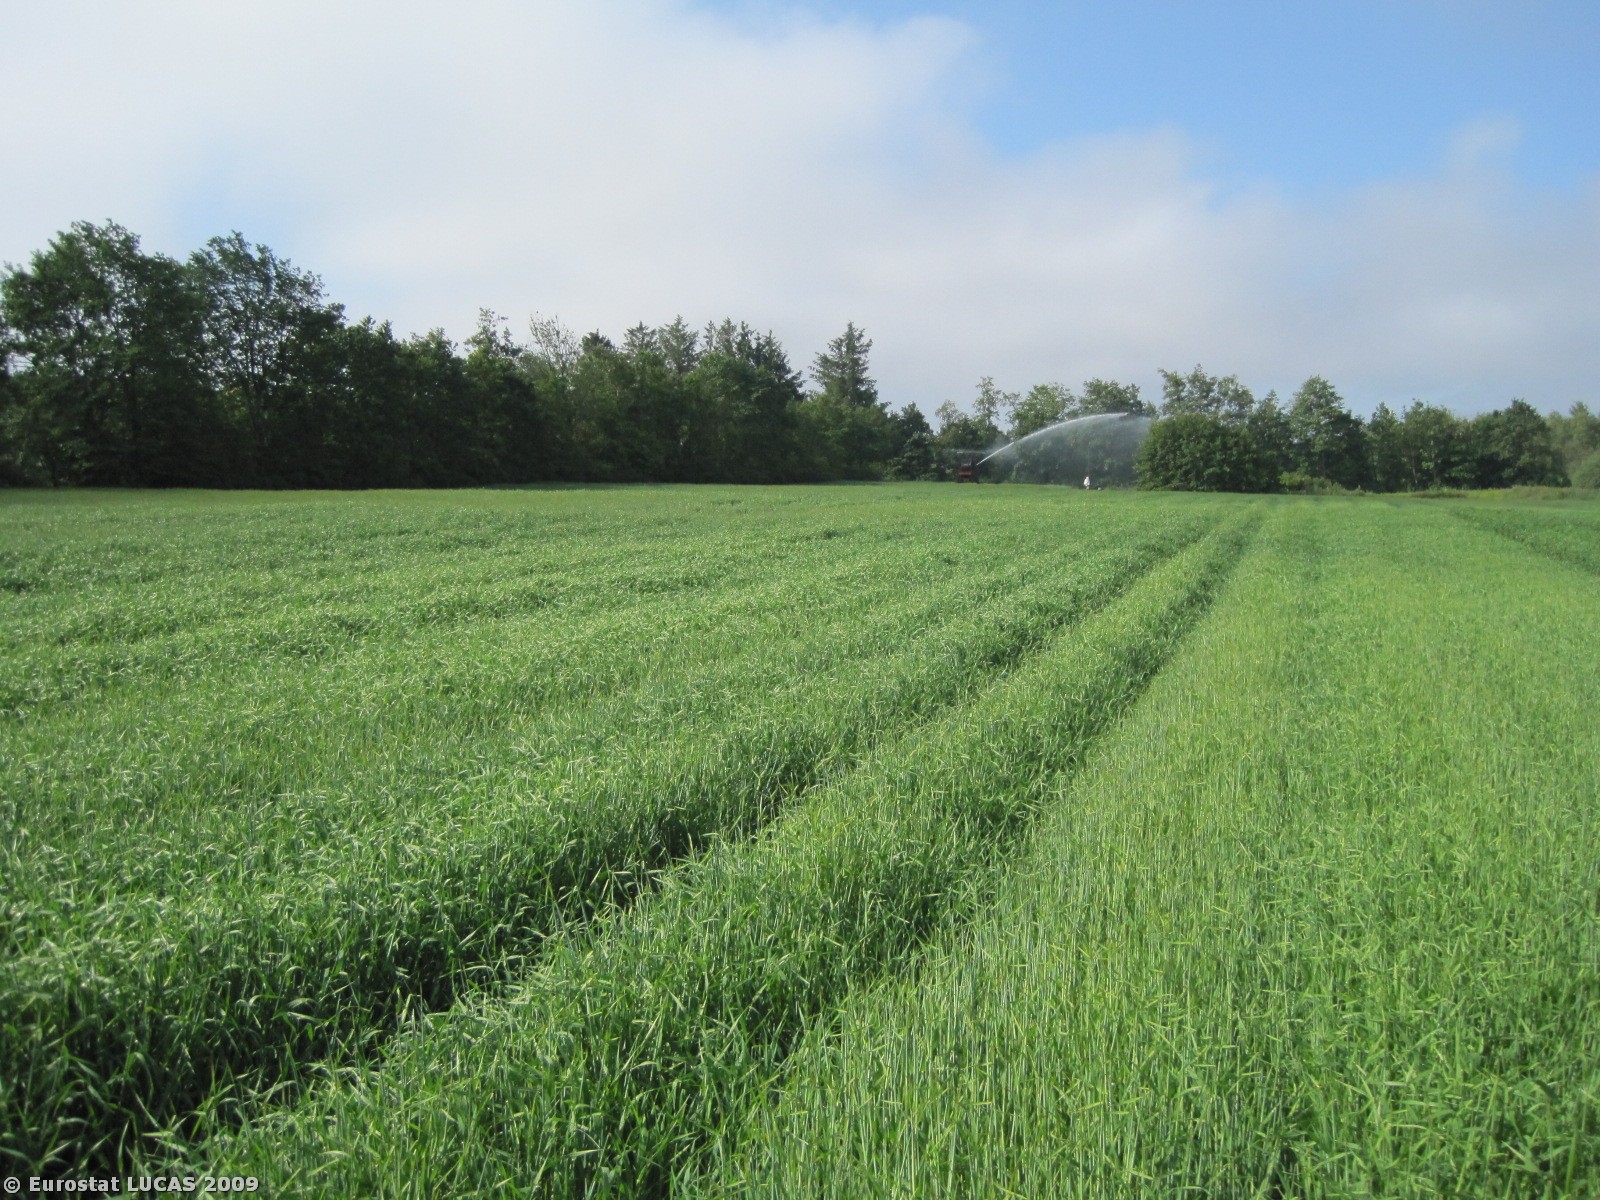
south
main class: Cropland
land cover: Barley
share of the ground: > 75 %
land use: Agriculture (excluding fallow land and kitchen gardens)
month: June
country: DK
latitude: 56.3275
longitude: 8.9824
